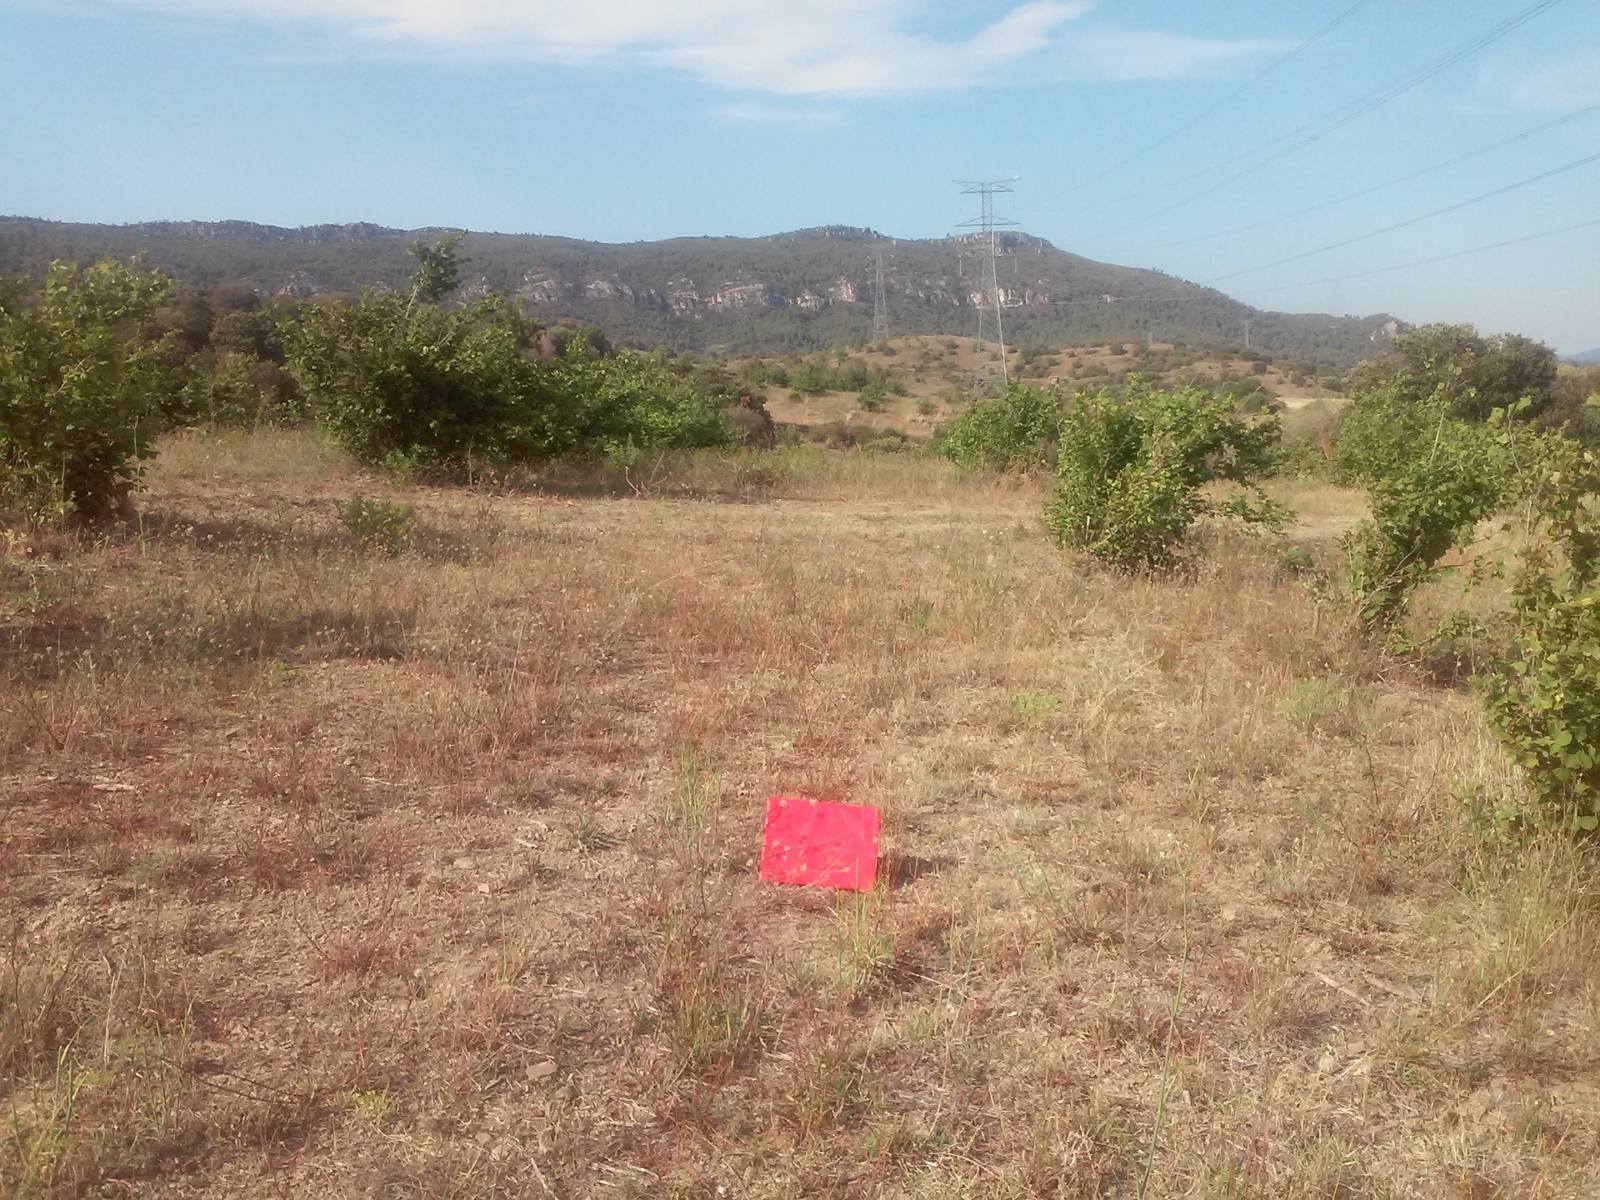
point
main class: Cropland
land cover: Nuts trees
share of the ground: < 10 %
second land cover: Grassland without tree/shrub cover
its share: > 75 %
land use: Agriculture (excluding fallow land and kitchen gardens)
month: June
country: ES
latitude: 41.3668
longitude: 1.2529
